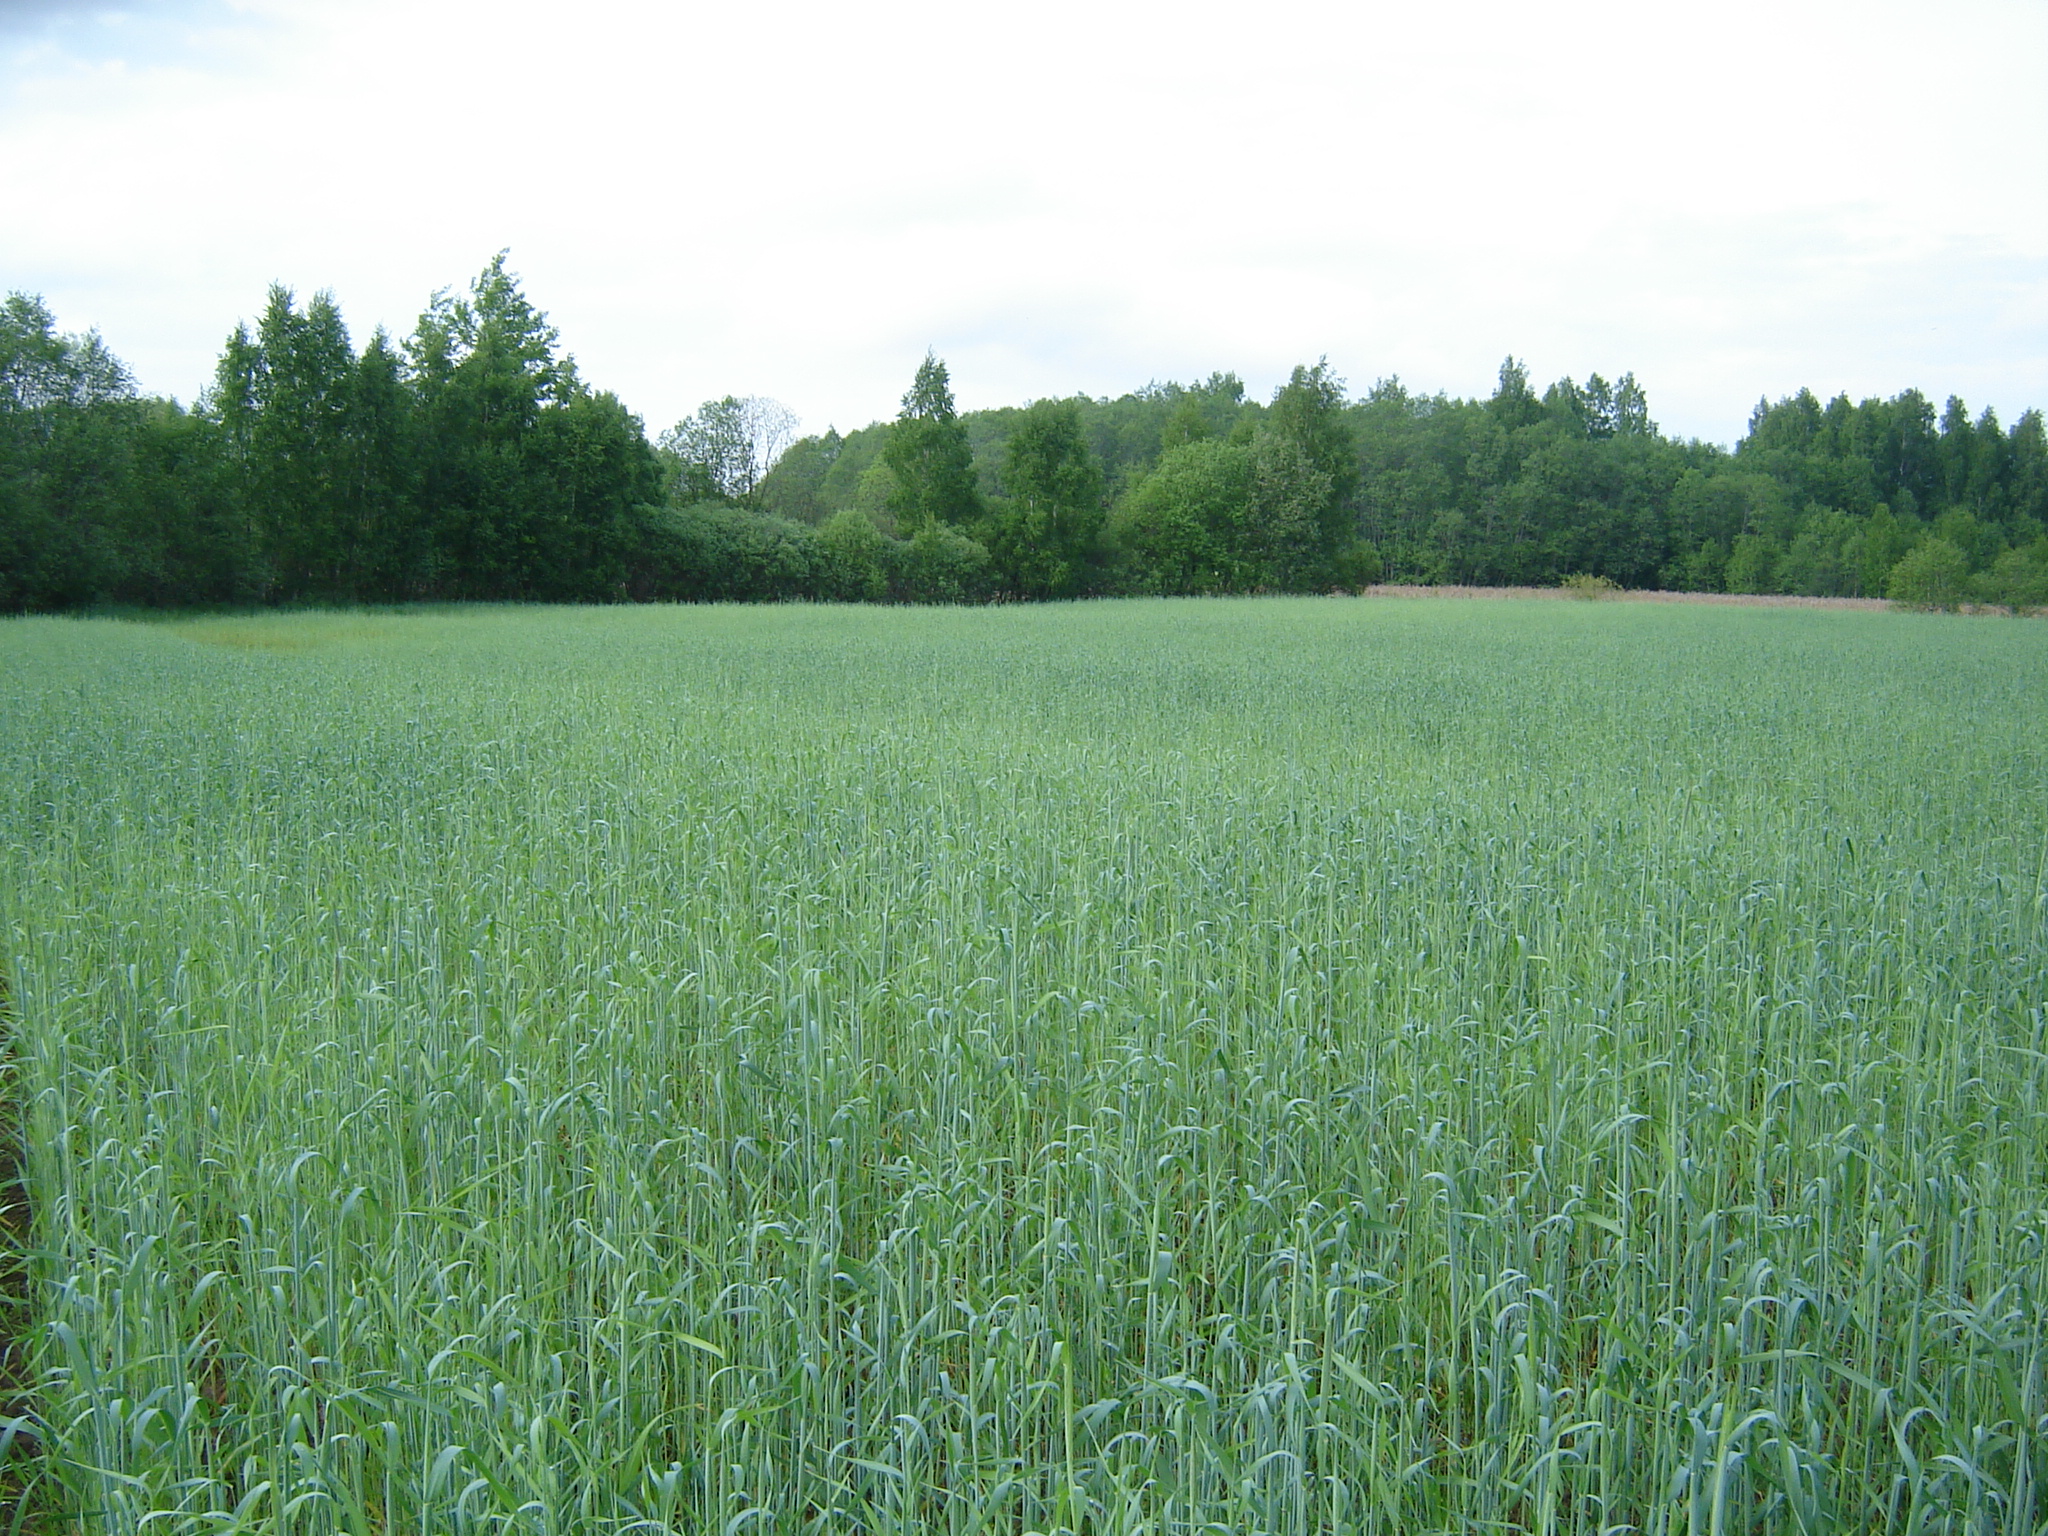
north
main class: Cropland
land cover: Rye
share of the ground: > 75 %
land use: Agriculture (excluding fallow land and kitchen gardens)
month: May
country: LT
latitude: 55.9630
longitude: 25.4190
